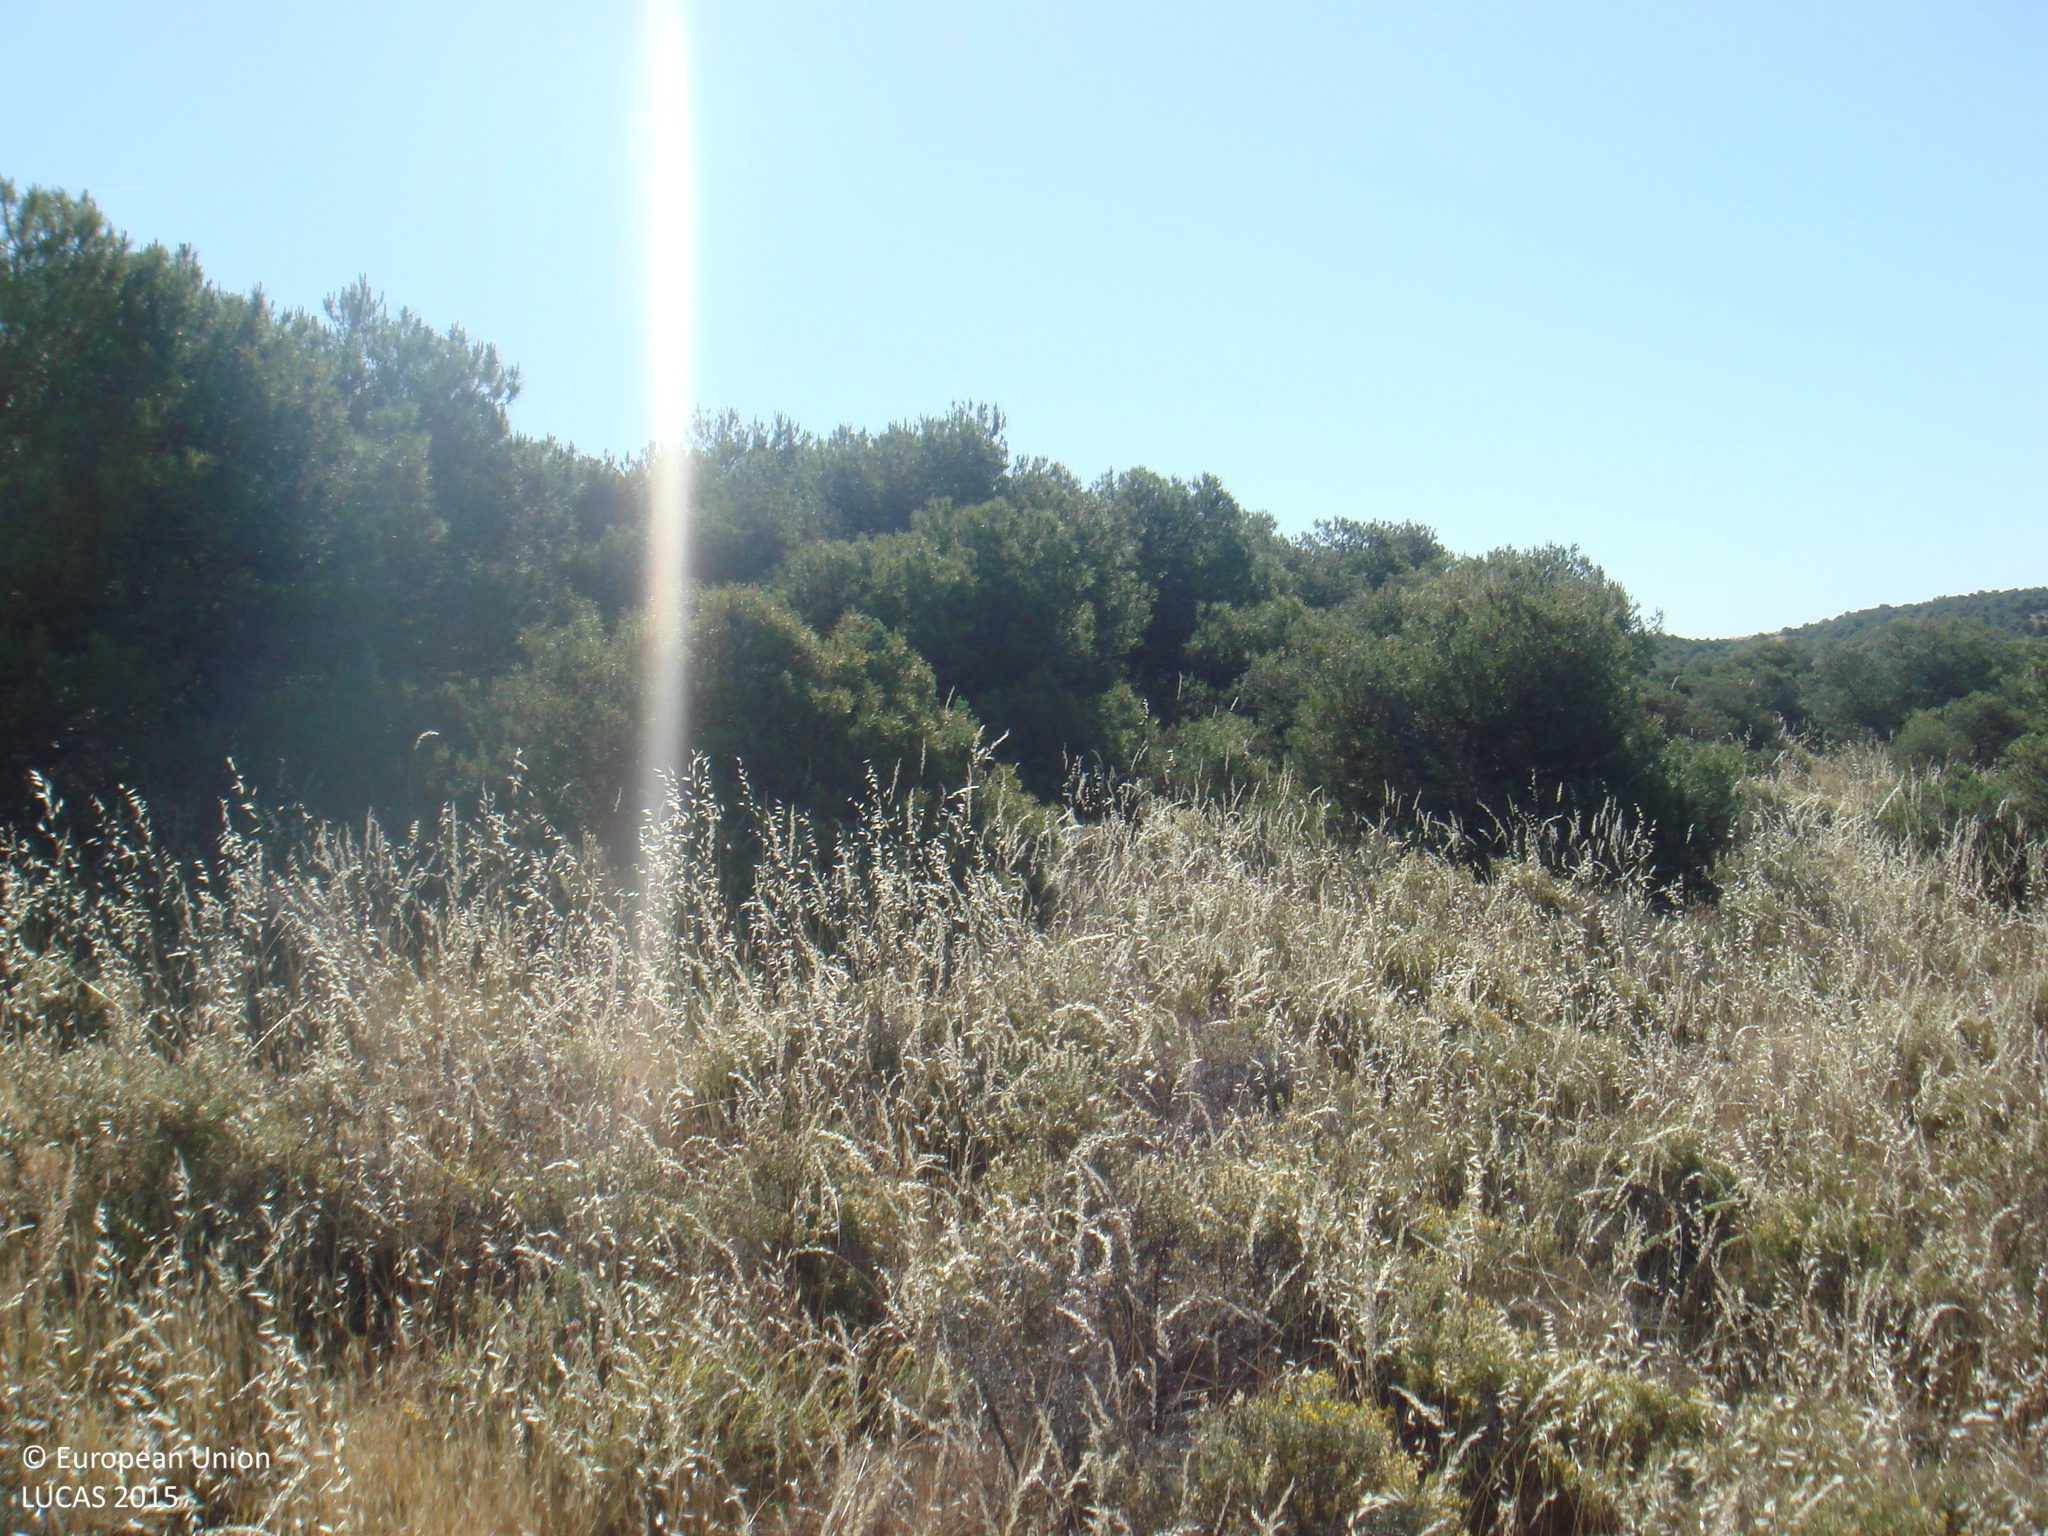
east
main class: Woodland
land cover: Pine dominated coniferous woodland
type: coniferous forest of the mediterranean region
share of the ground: 10 - 25 %
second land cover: Shrubland without tree cover
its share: 10 - 25 %
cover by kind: herbaceous plants 65 %, coniferous forest trees 25 %, shrubs 10 %
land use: Forestry
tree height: < 5 m
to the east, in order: Pine dominated coniferous woodland; Shrubland without tree cover; Rock outcrops; Pine dominated coniferous woodland; Rock outcrops
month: May
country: ES
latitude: 38.6045
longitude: -5.1548
